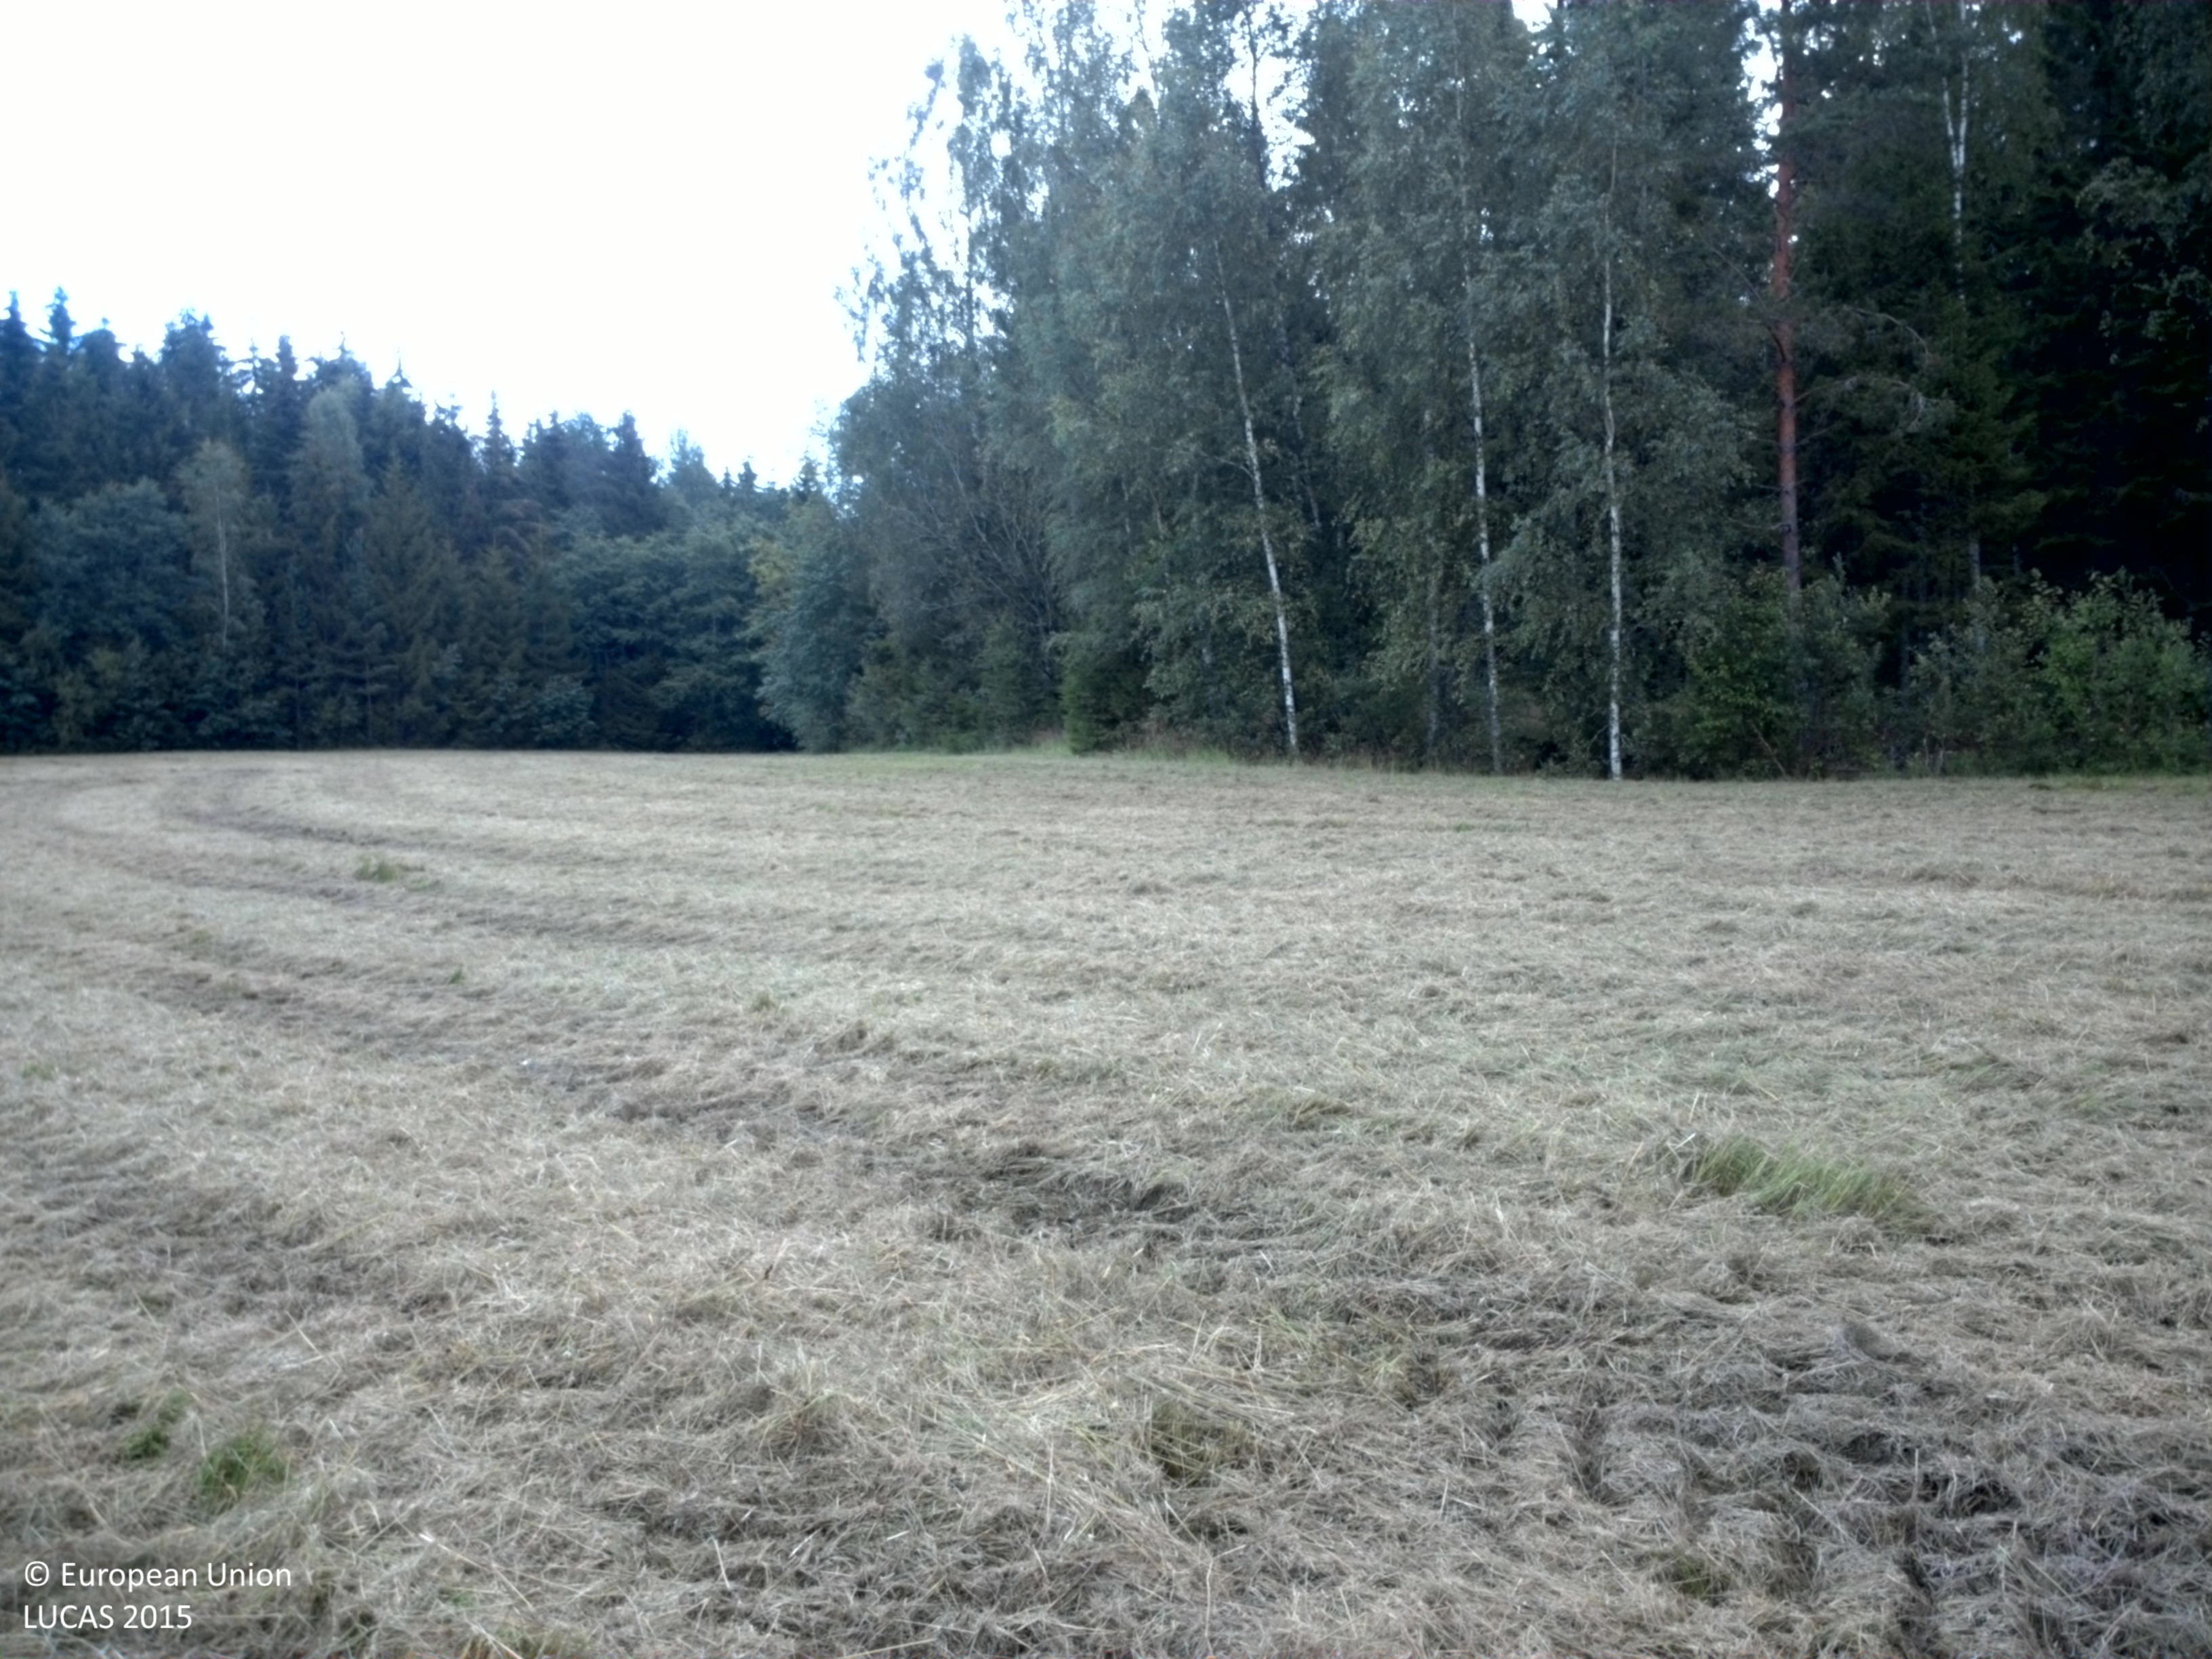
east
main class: Grassland
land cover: Grassland without tree/shrub cover
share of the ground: > 75 %
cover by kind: herbaceous plants 90 %, consolidated bare surface 10 %
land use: Agriculture (excluding fallow land and kitchen gardens)
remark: Harvested field
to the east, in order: Grassland without tree/shrub cover; Broadleaved woodland; Grassland without tree/shrub cover; Ditches and canals; Spruce dominated mixed woodland; Ditches and canals; Spruce dominated mixed woodland; Grassland with sparse tree/shrub cover; Spruce dominated coniferous woodland; Ditches and canals; Spruce dominated mixed woodland
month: August
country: SE
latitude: 59.5860
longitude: 13.1976
